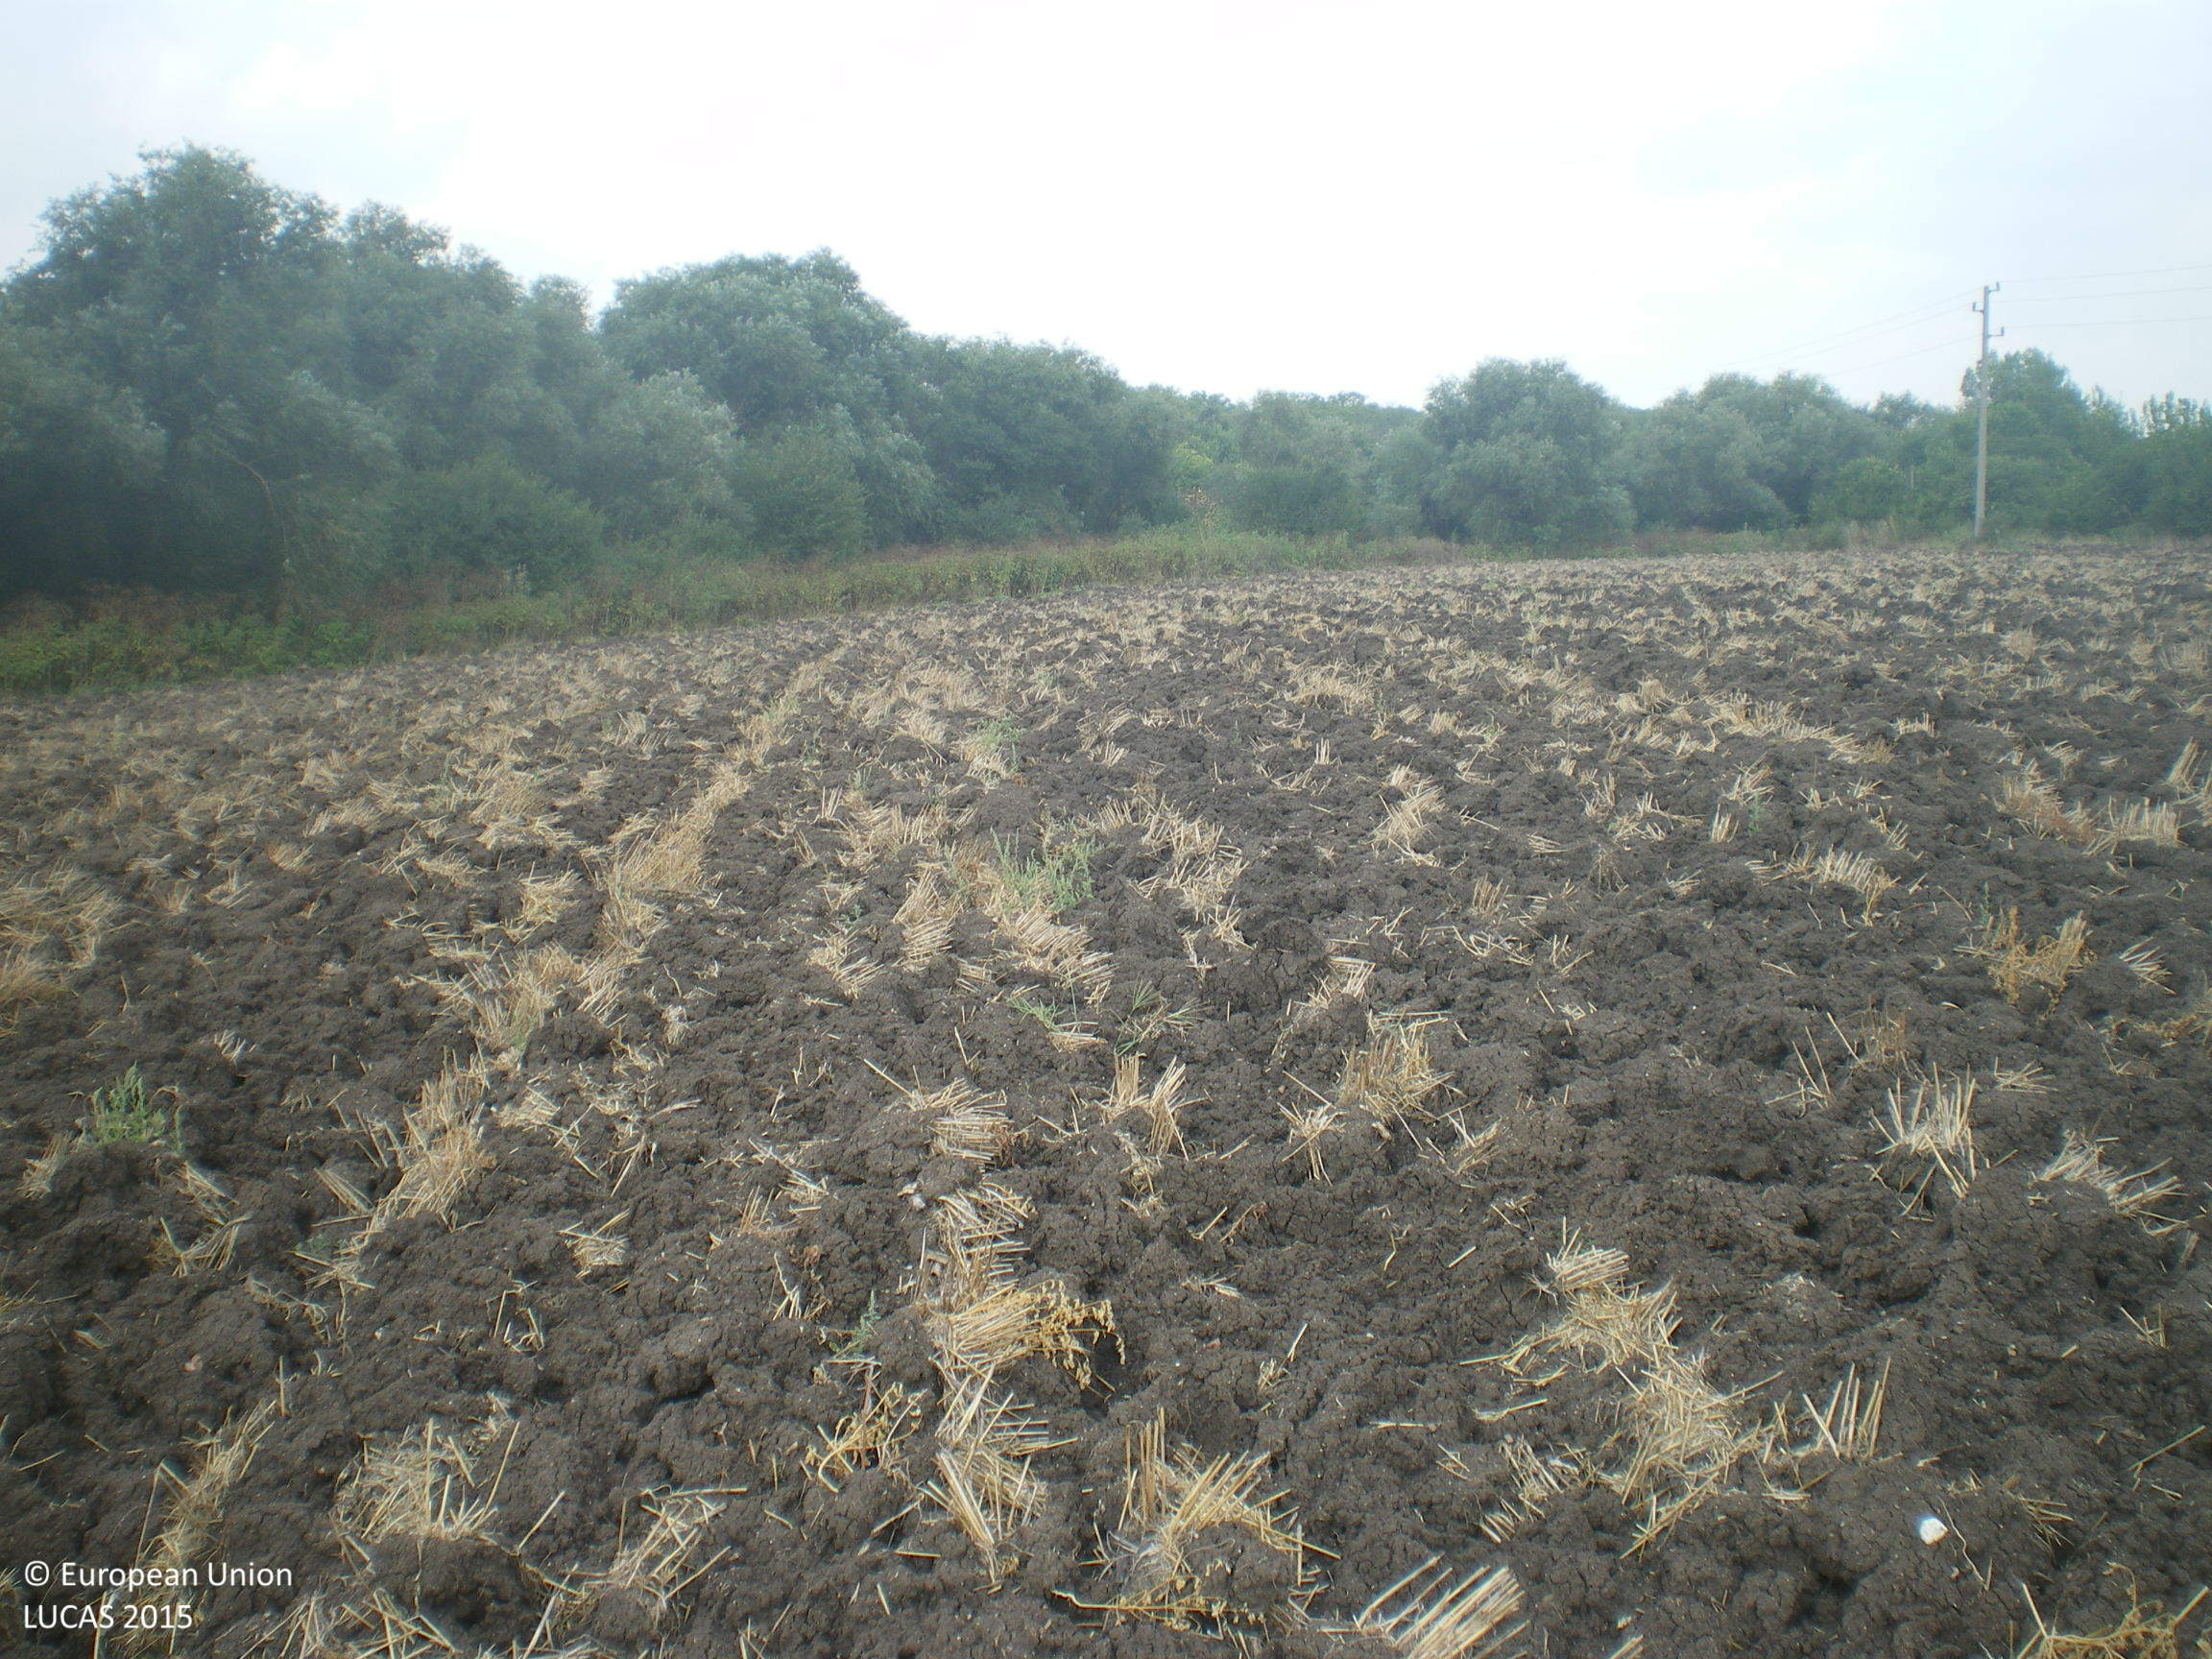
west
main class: Cropland
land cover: Common wheat
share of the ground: < 10 %
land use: Agriculture (excluding fallow land and kitchen gardens)
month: August
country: BG
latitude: 42.3174
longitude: 25.8361
